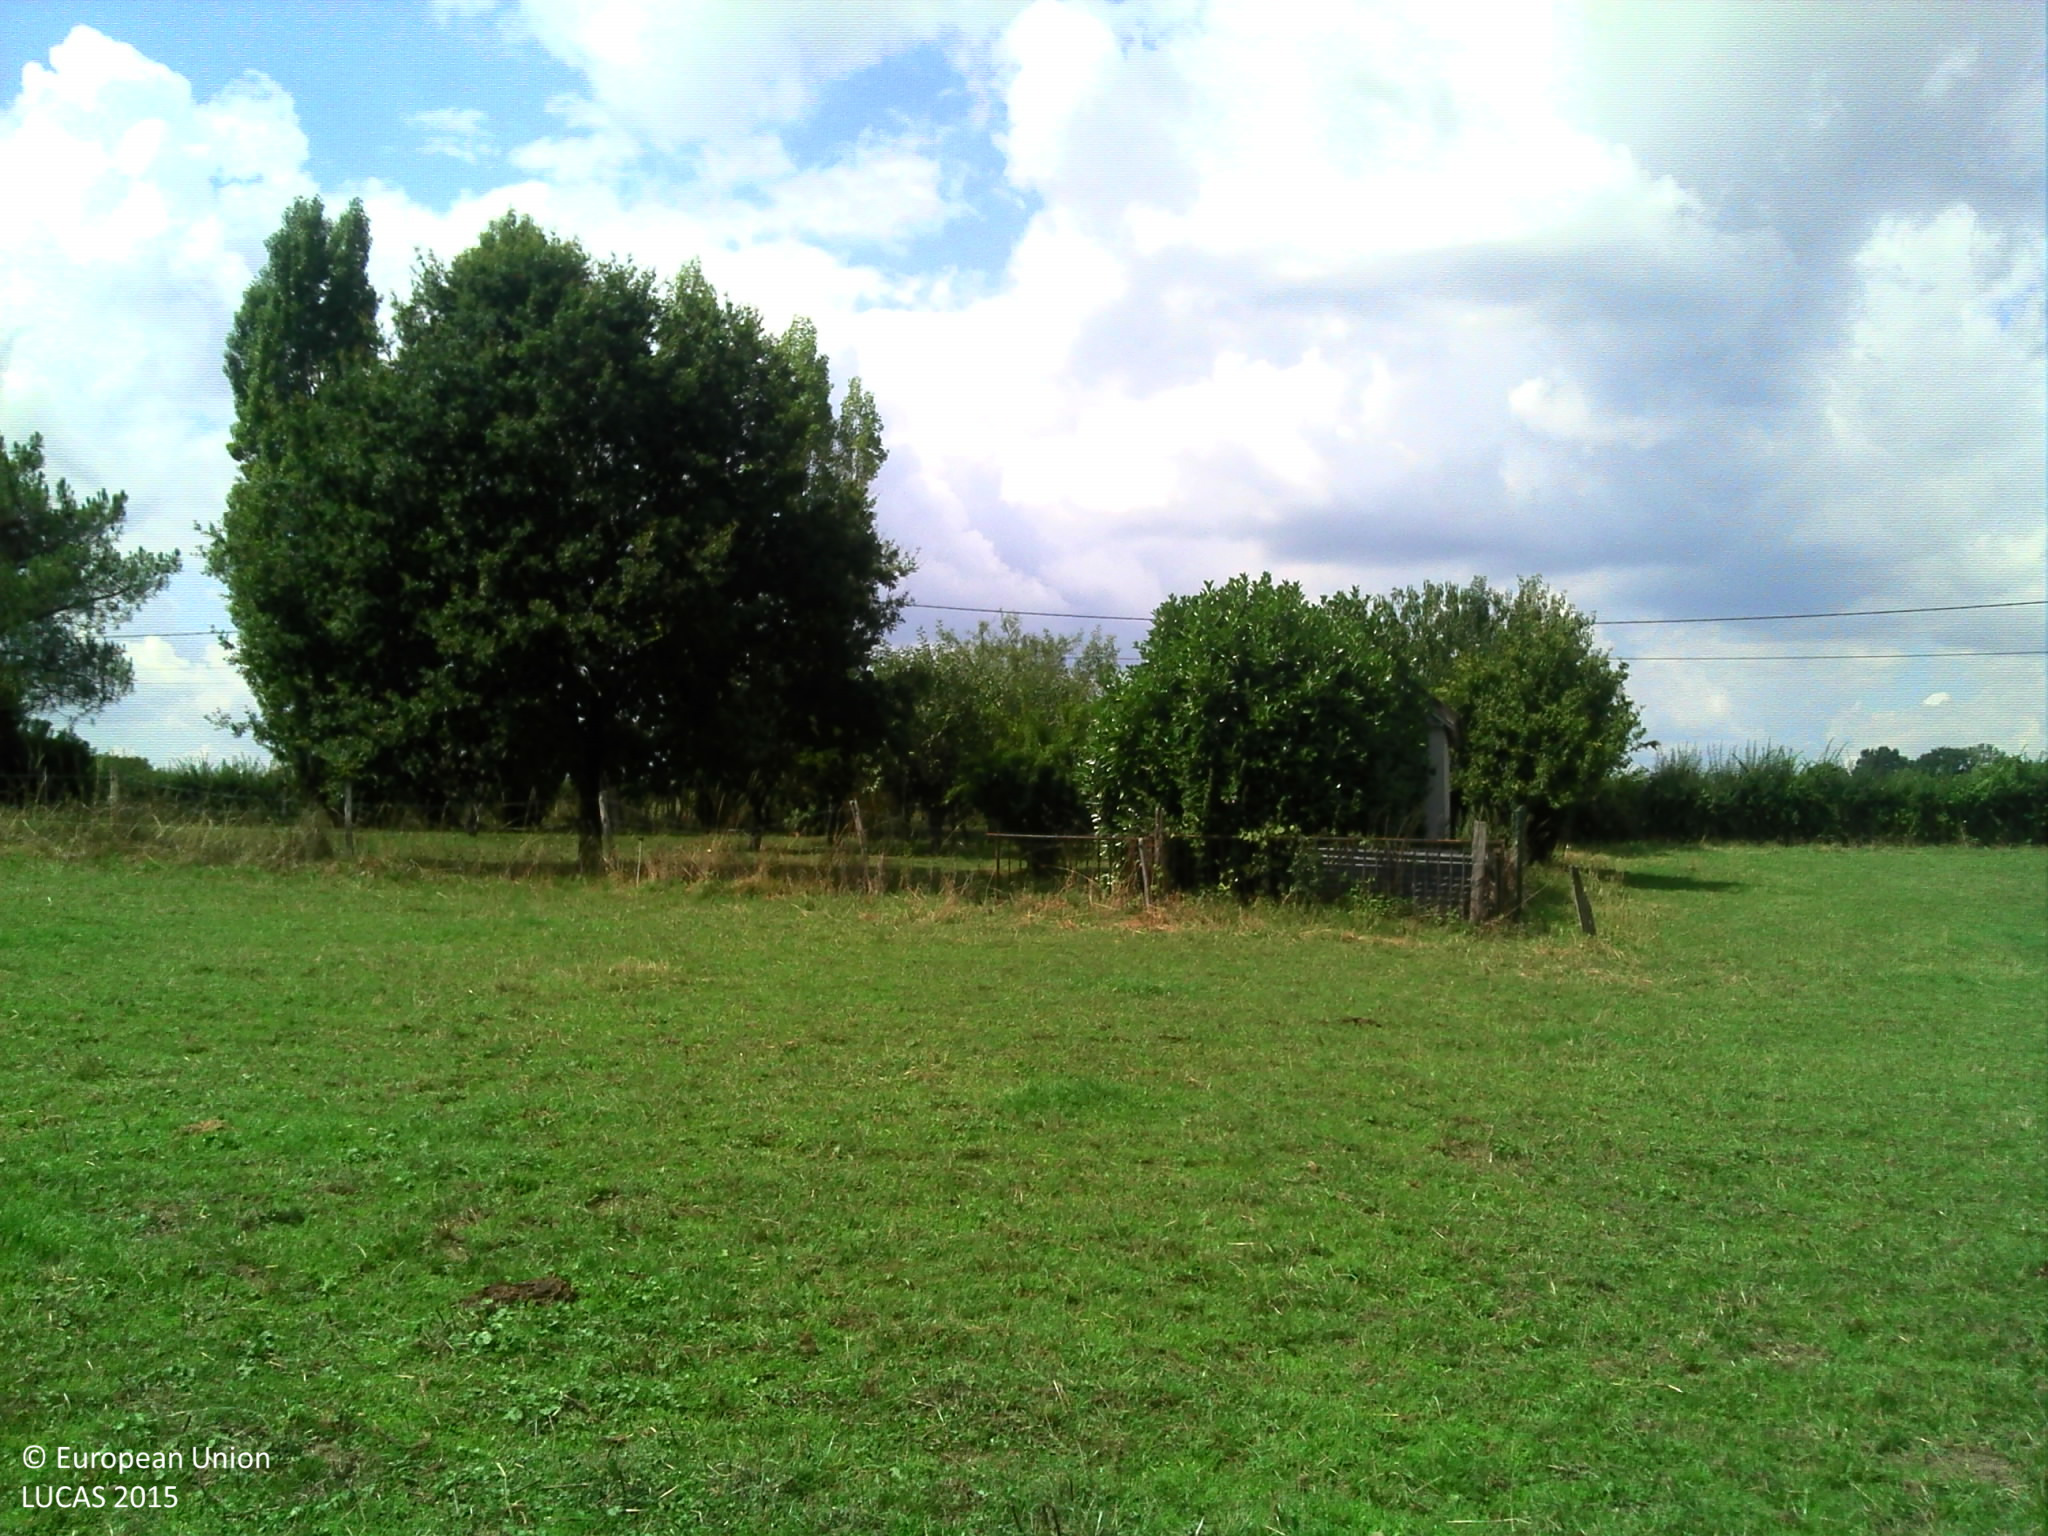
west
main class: Grassland
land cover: Grassland without tree/shrub cover
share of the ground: > 75 %
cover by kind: herbaceous plants 100 %
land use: Agriculture (excluding fallow land and kitchen gardens)
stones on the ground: < 10 %
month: August
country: FR
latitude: 46.5212
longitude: 3.3111
